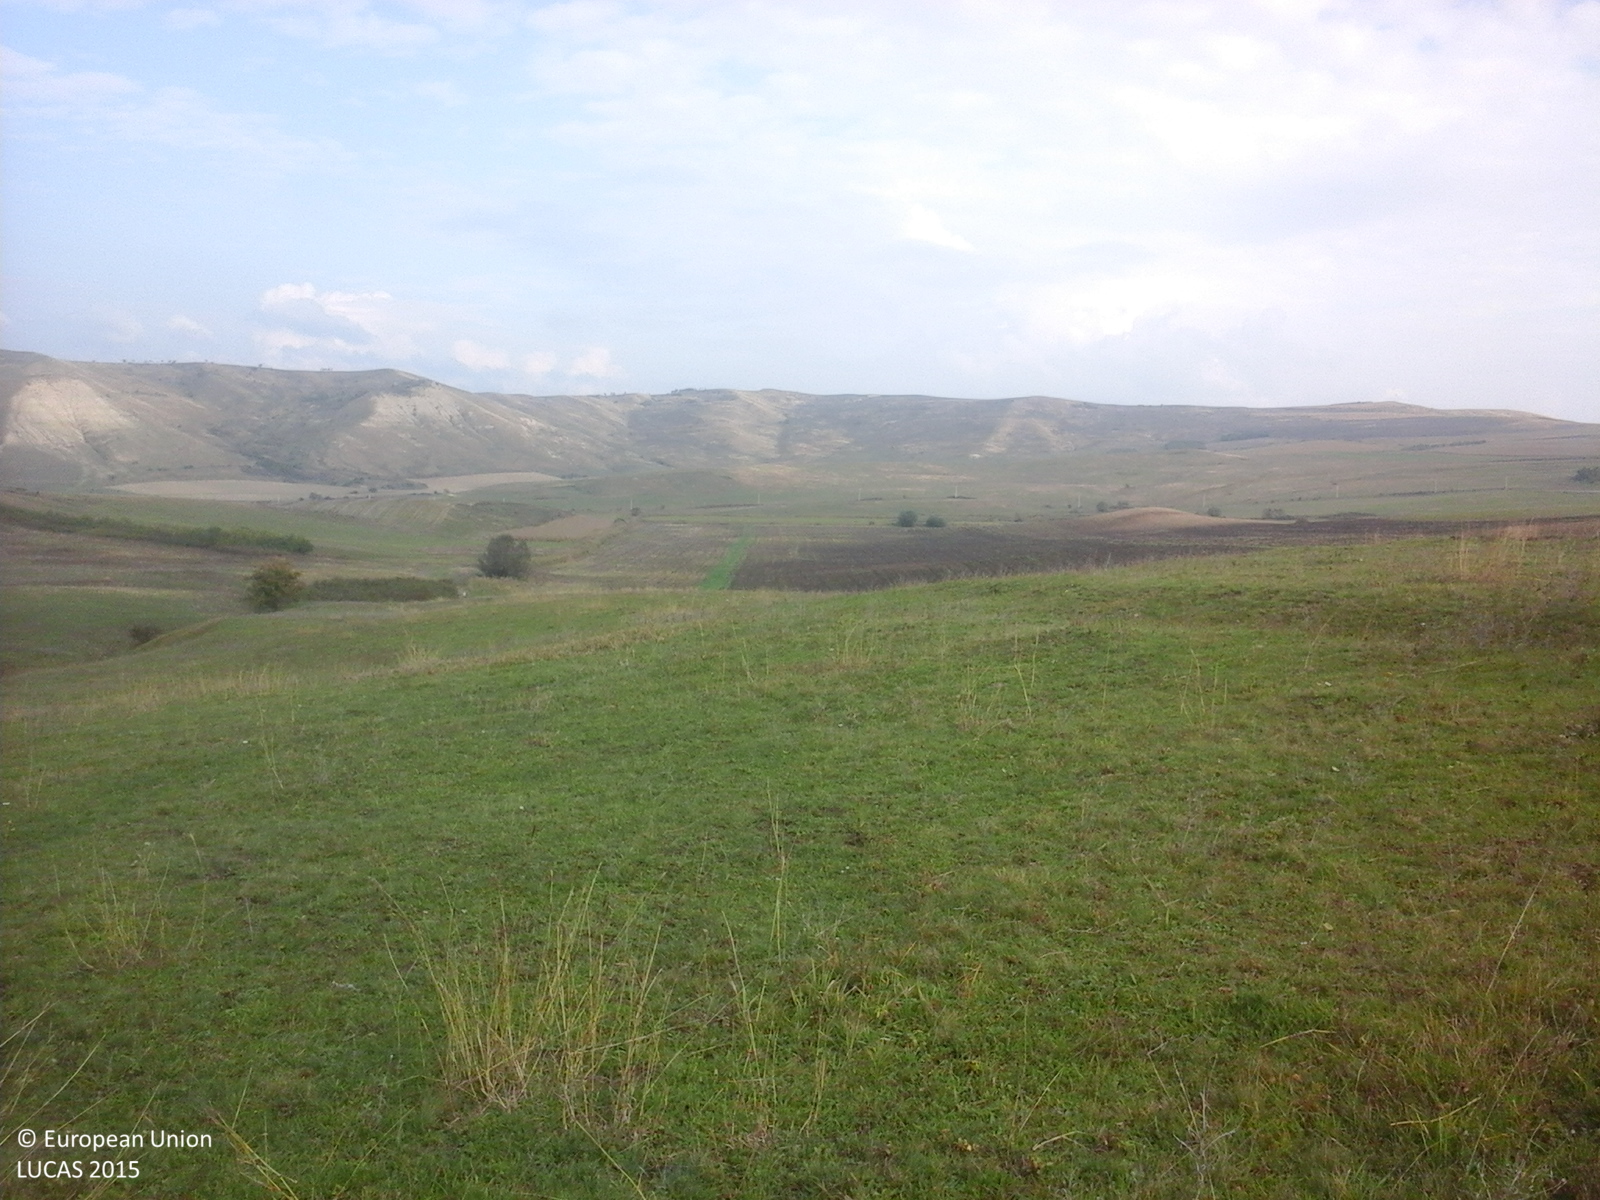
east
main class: Cropland
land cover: Sunflower
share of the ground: > 75 %
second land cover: Spontaneously vegetated surfaces
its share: 50 - 75 %
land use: Agriculture (excluding fallow land and kitchen gardens)
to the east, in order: Sunflower; Spontaneously vegetated surfaces; Grassland without tree/shrub cover; Ditches and canals; Grassland without tree/shrub cover
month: October
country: RO
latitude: 46.3044
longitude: 23.9809
